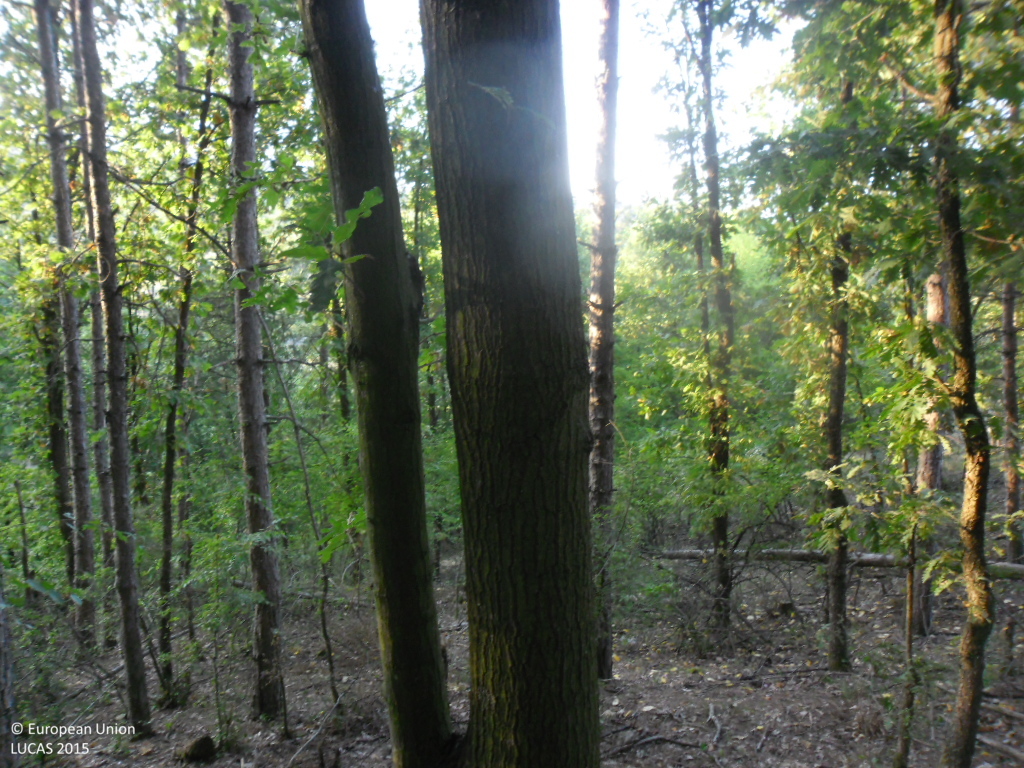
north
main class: Woodland
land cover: Pine dominated mixed woodland
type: hemiboreal forest and nemoral coniferous forest and mixed broadleaved-coniferous forest
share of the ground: > 75 %
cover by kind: coniferous forest trees 75 %, broadleaved forest trees 25 %
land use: Forestry
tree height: > 5 m
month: September
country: BG
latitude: 41.8373
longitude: 23.0880
